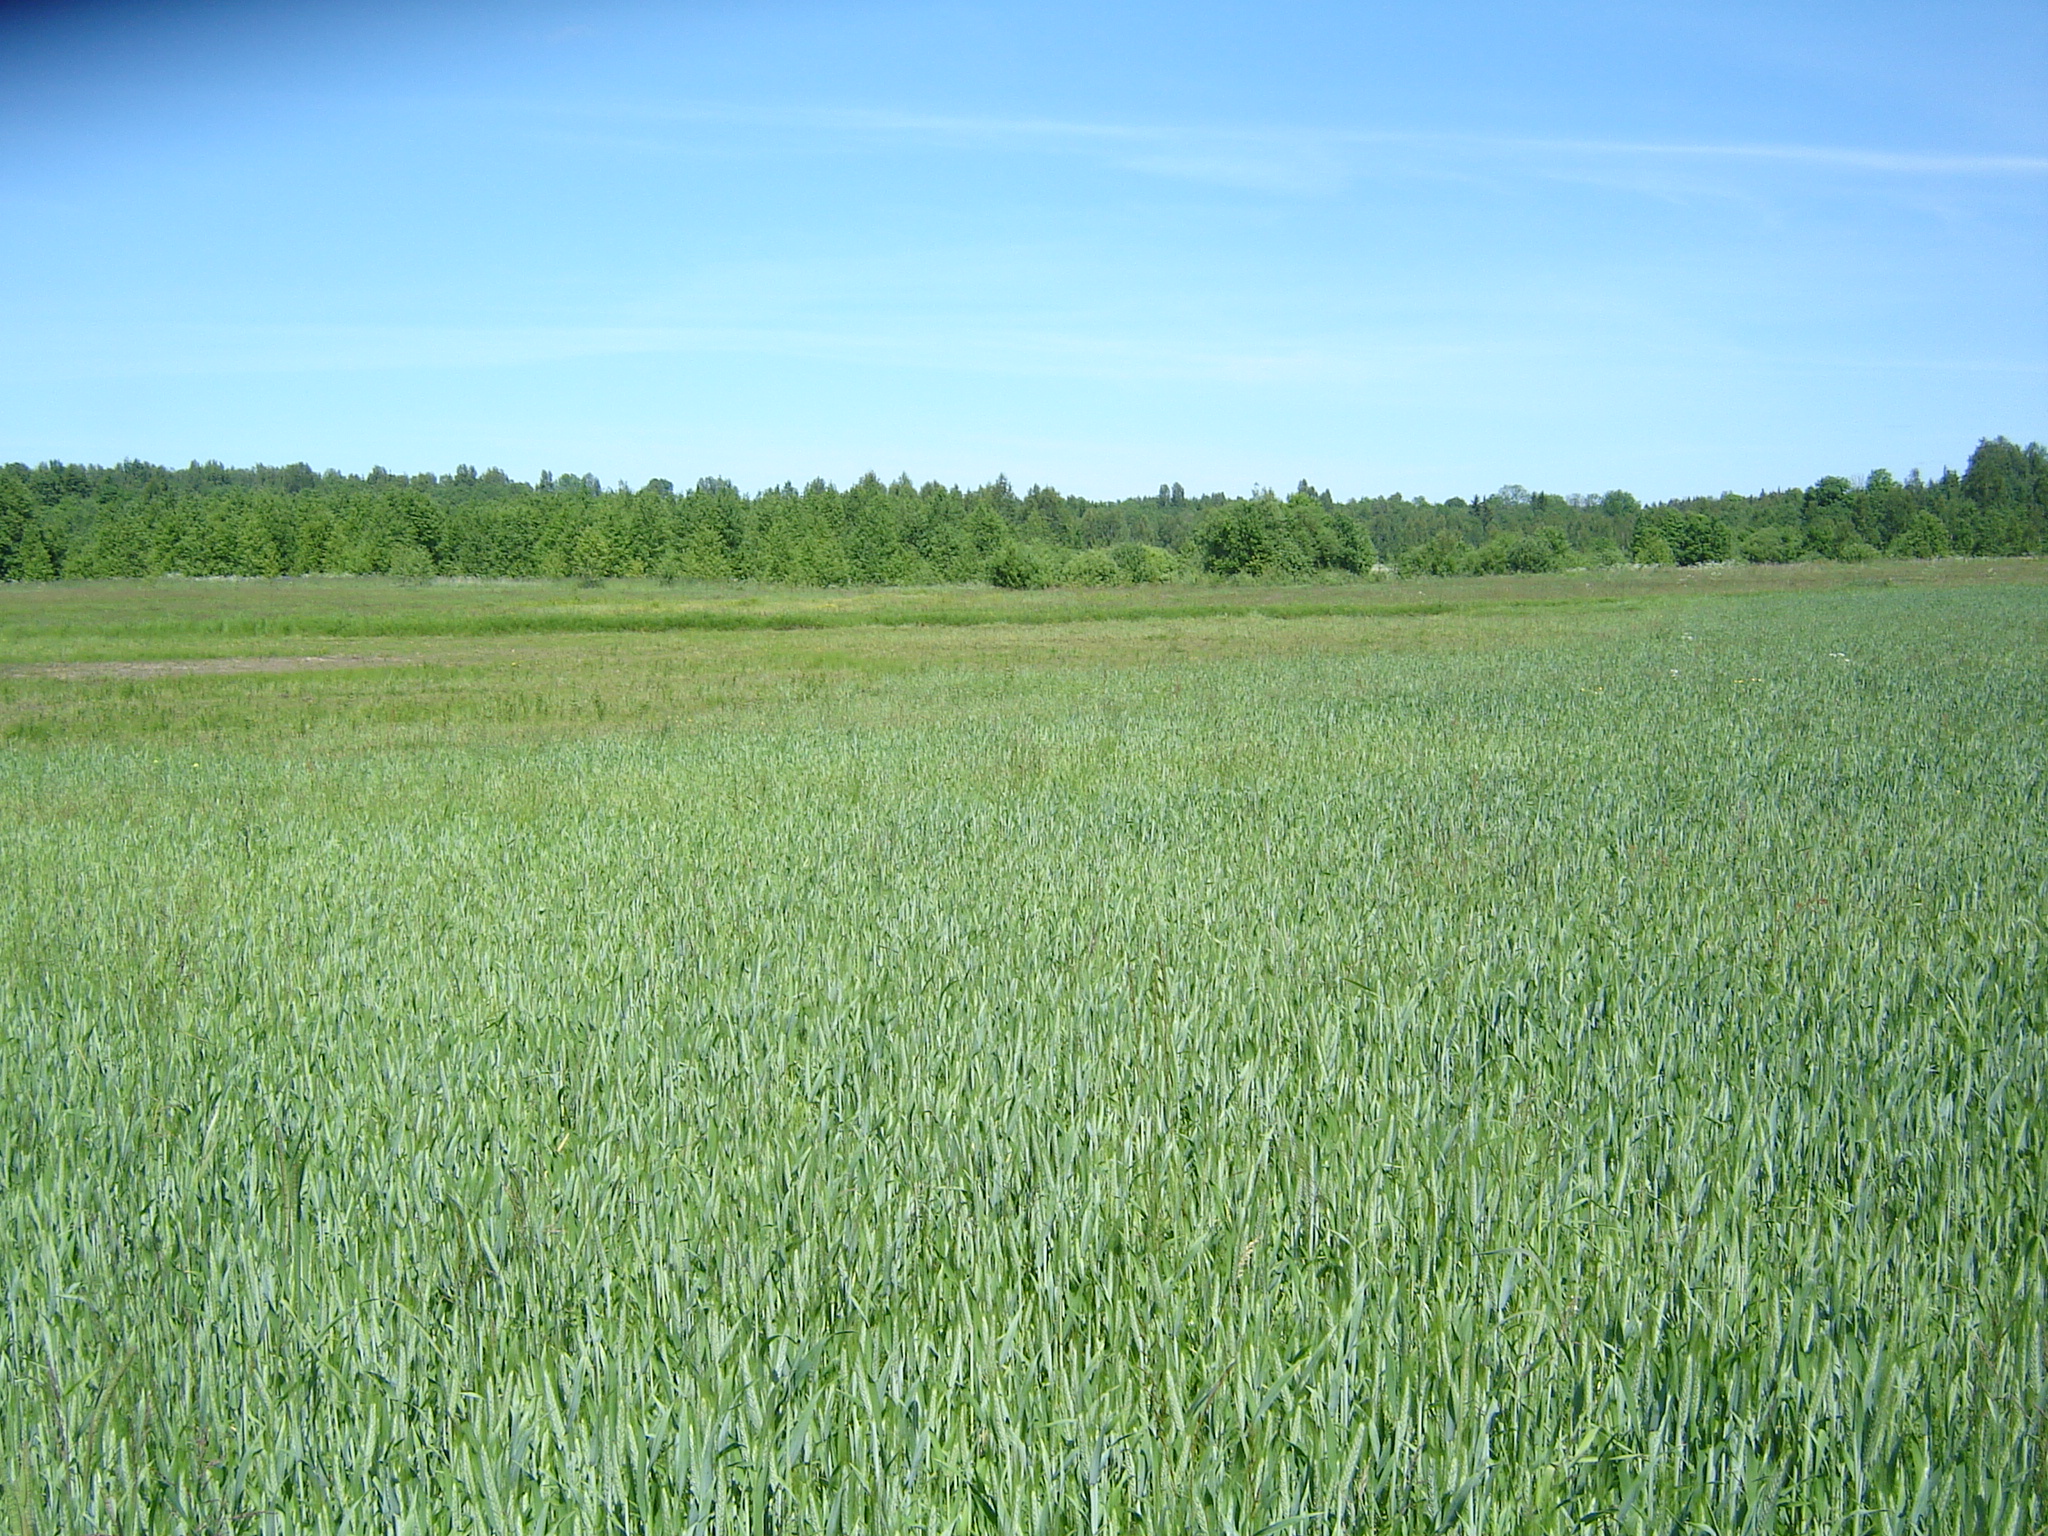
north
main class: Cropland
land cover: Rye
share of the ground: > 75 %
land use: Agriculture (excluding fallow land and kitchen gardens)
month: June
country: LT
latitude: 55.6745
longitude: 25.0760
